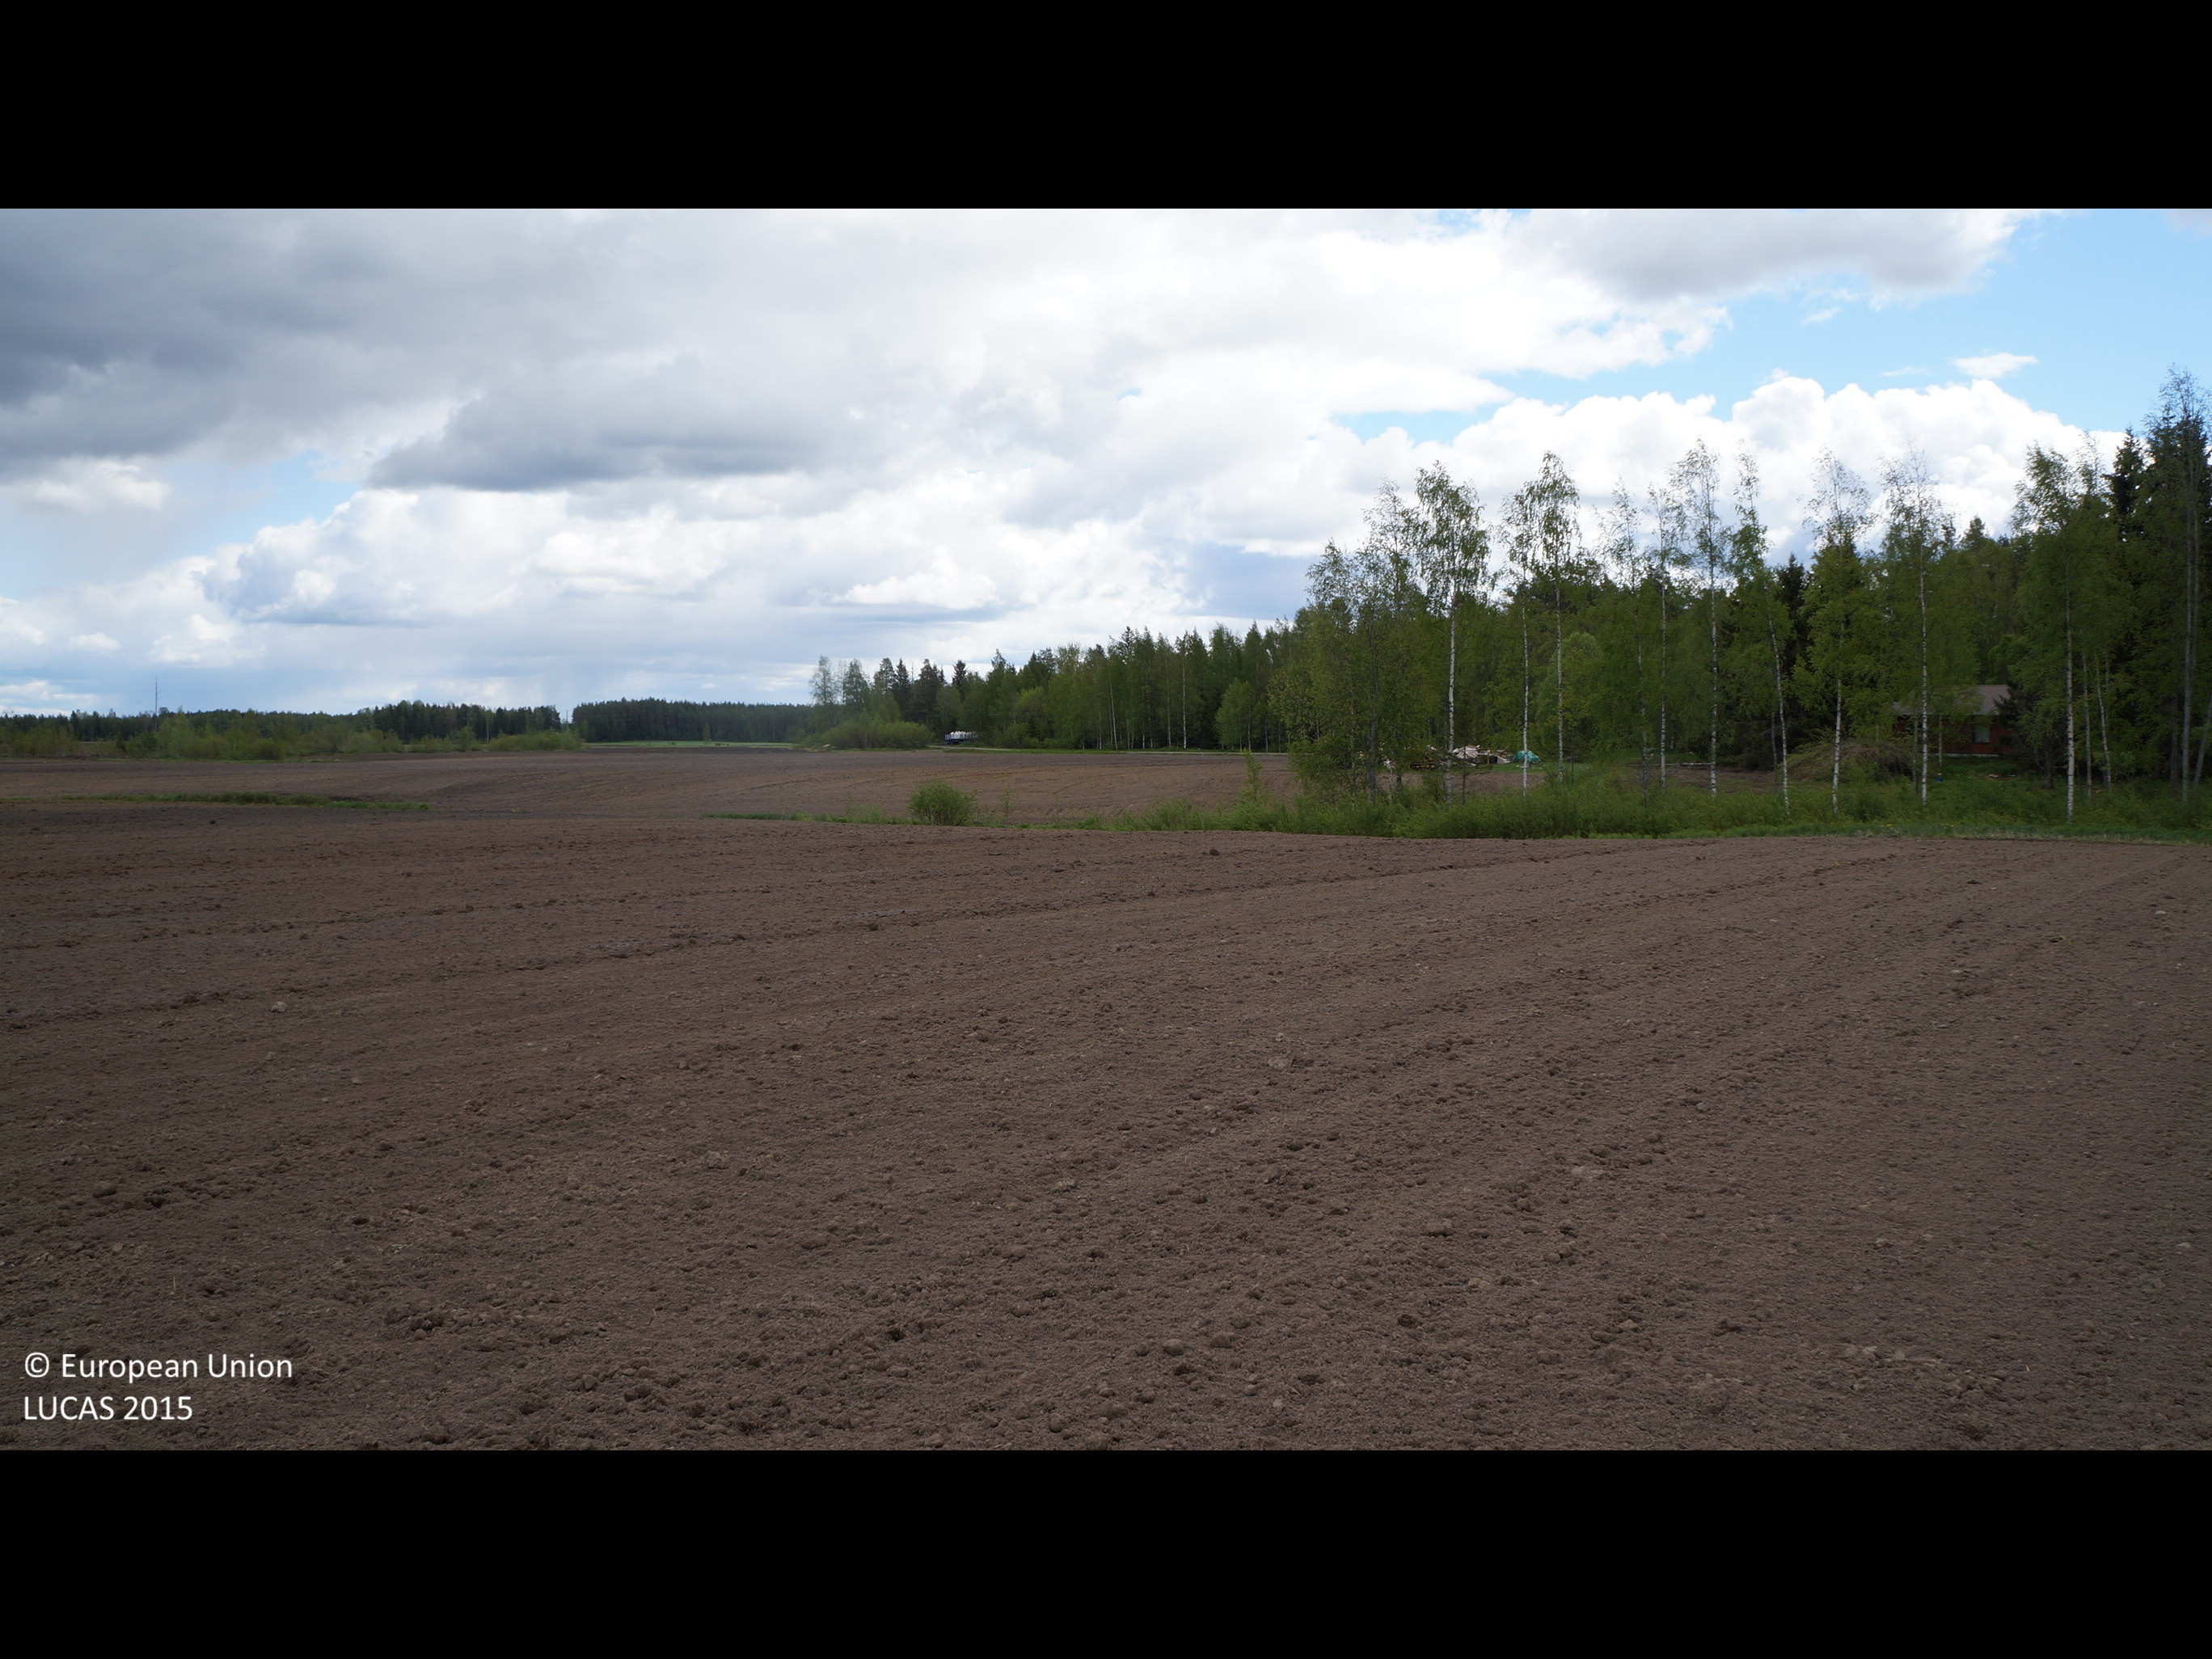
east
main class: Cropland
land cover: Barley
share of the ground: < 10 %
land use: Agriculture (excluding fallow land and kitchen gardens)
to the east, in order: Barley; Ditches and canals; Grassland without tree/shrub cover; Rape and turnip rape
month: June
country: FI
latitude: 63.7129
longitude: 24.2603
